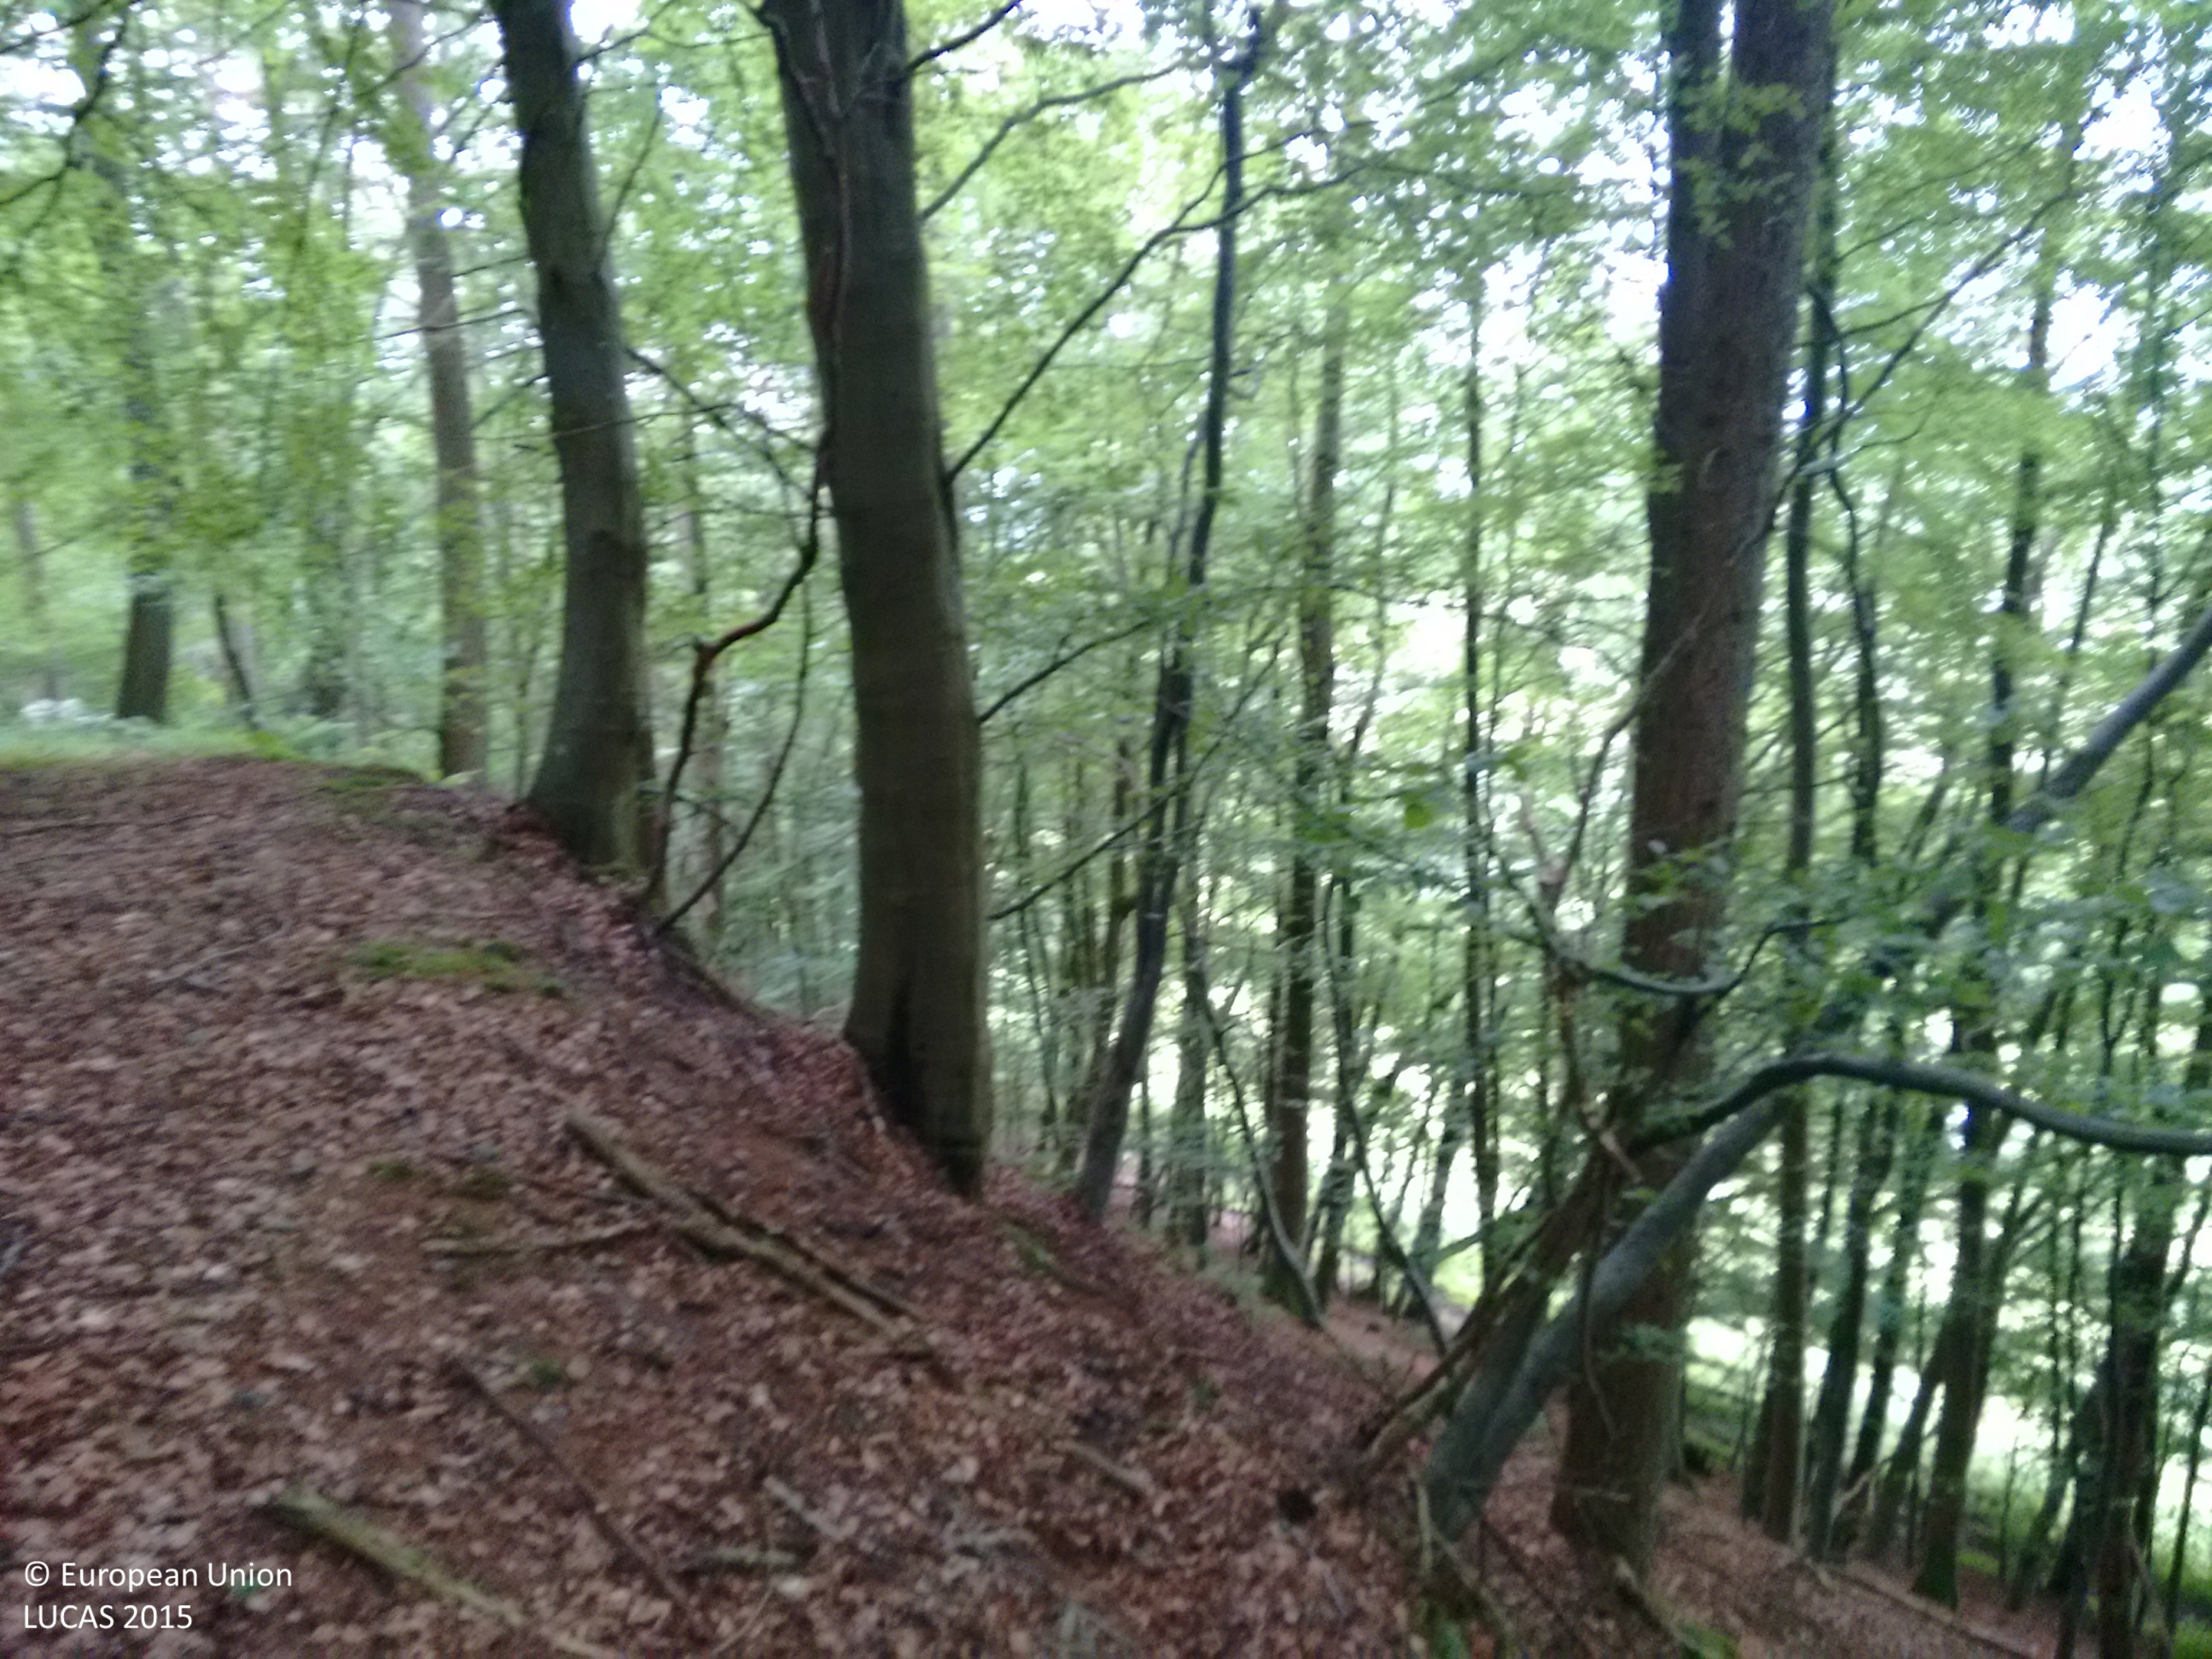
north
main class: Woodland
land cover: Broadleaved woodland
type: mesophytic deciduous forest
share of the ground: > 75 %
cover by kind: broadleaved forest trees 100 %
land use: Semi-natural and natural areas not in use
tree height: > 5 m
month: July
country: GB
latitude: 55.0338
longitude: -3.6487
